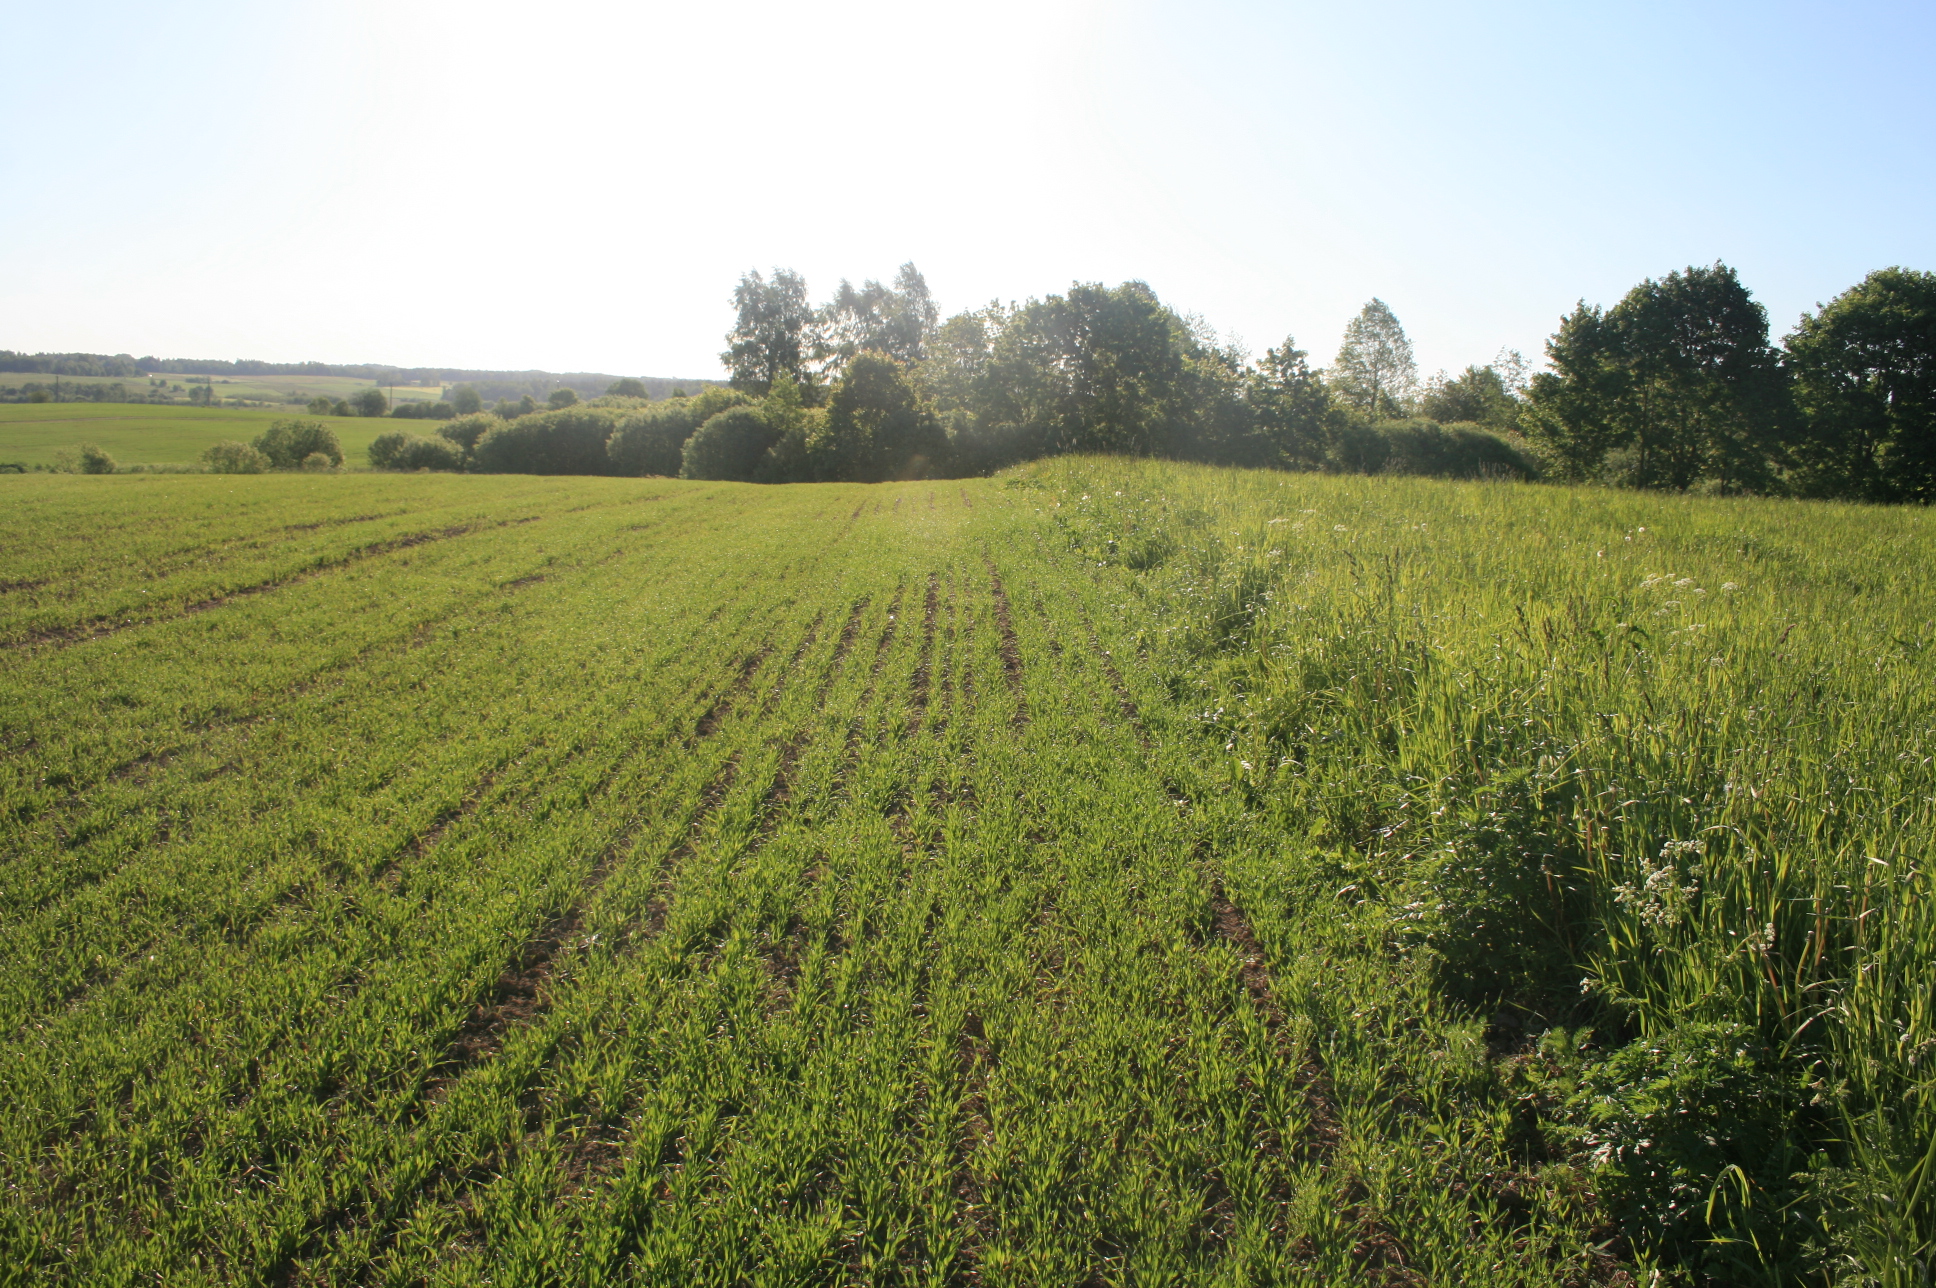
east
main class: Cropland
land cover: Barley
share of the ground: > 75 %
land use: Agriculture (excluding fallow land and kitchen gardens)
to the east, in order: Barley; Grassland without tree/shrub cover; Broadleaved woodland; Spontaneously vegetated surfaces; Barley
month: June
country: LT
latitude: 55.9131
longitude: 22.0028
